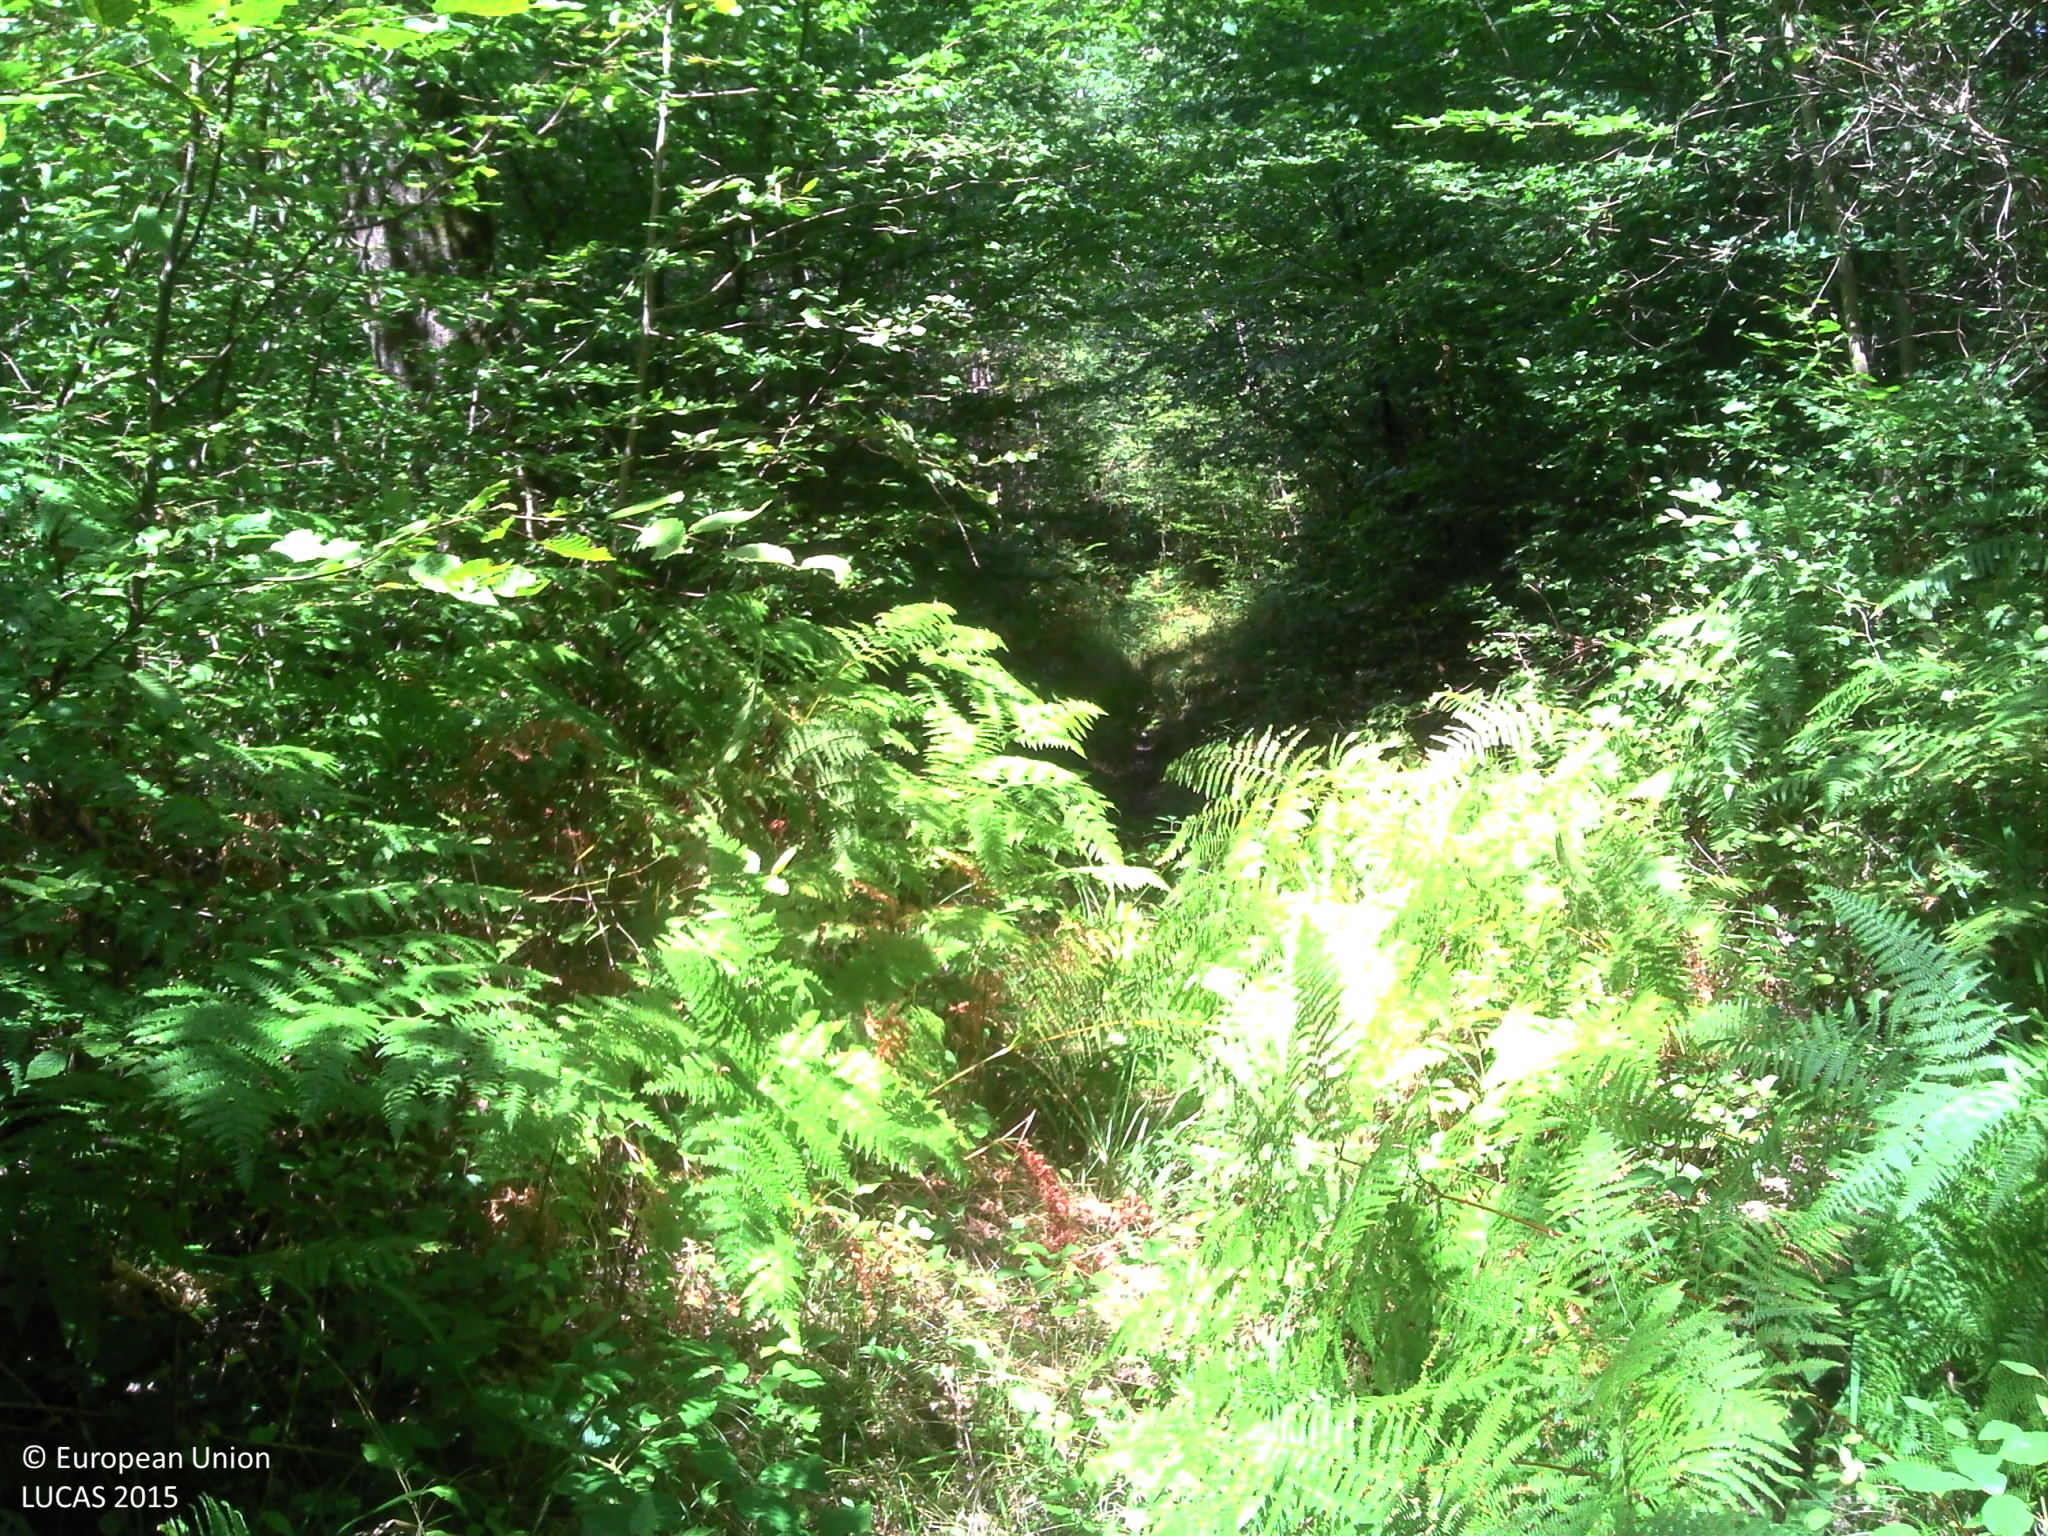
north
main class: Woodland
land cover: Broadleaved woodland
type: mesophytic deciduous forest
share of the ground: > 75 %
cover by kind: broadleaved forest trees 60 %, herbaceous plants 35 %, shrubs 5 %
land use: Forestry
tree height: > 5 m
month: July
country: FR
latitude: 46.6623
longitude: 4.8916
